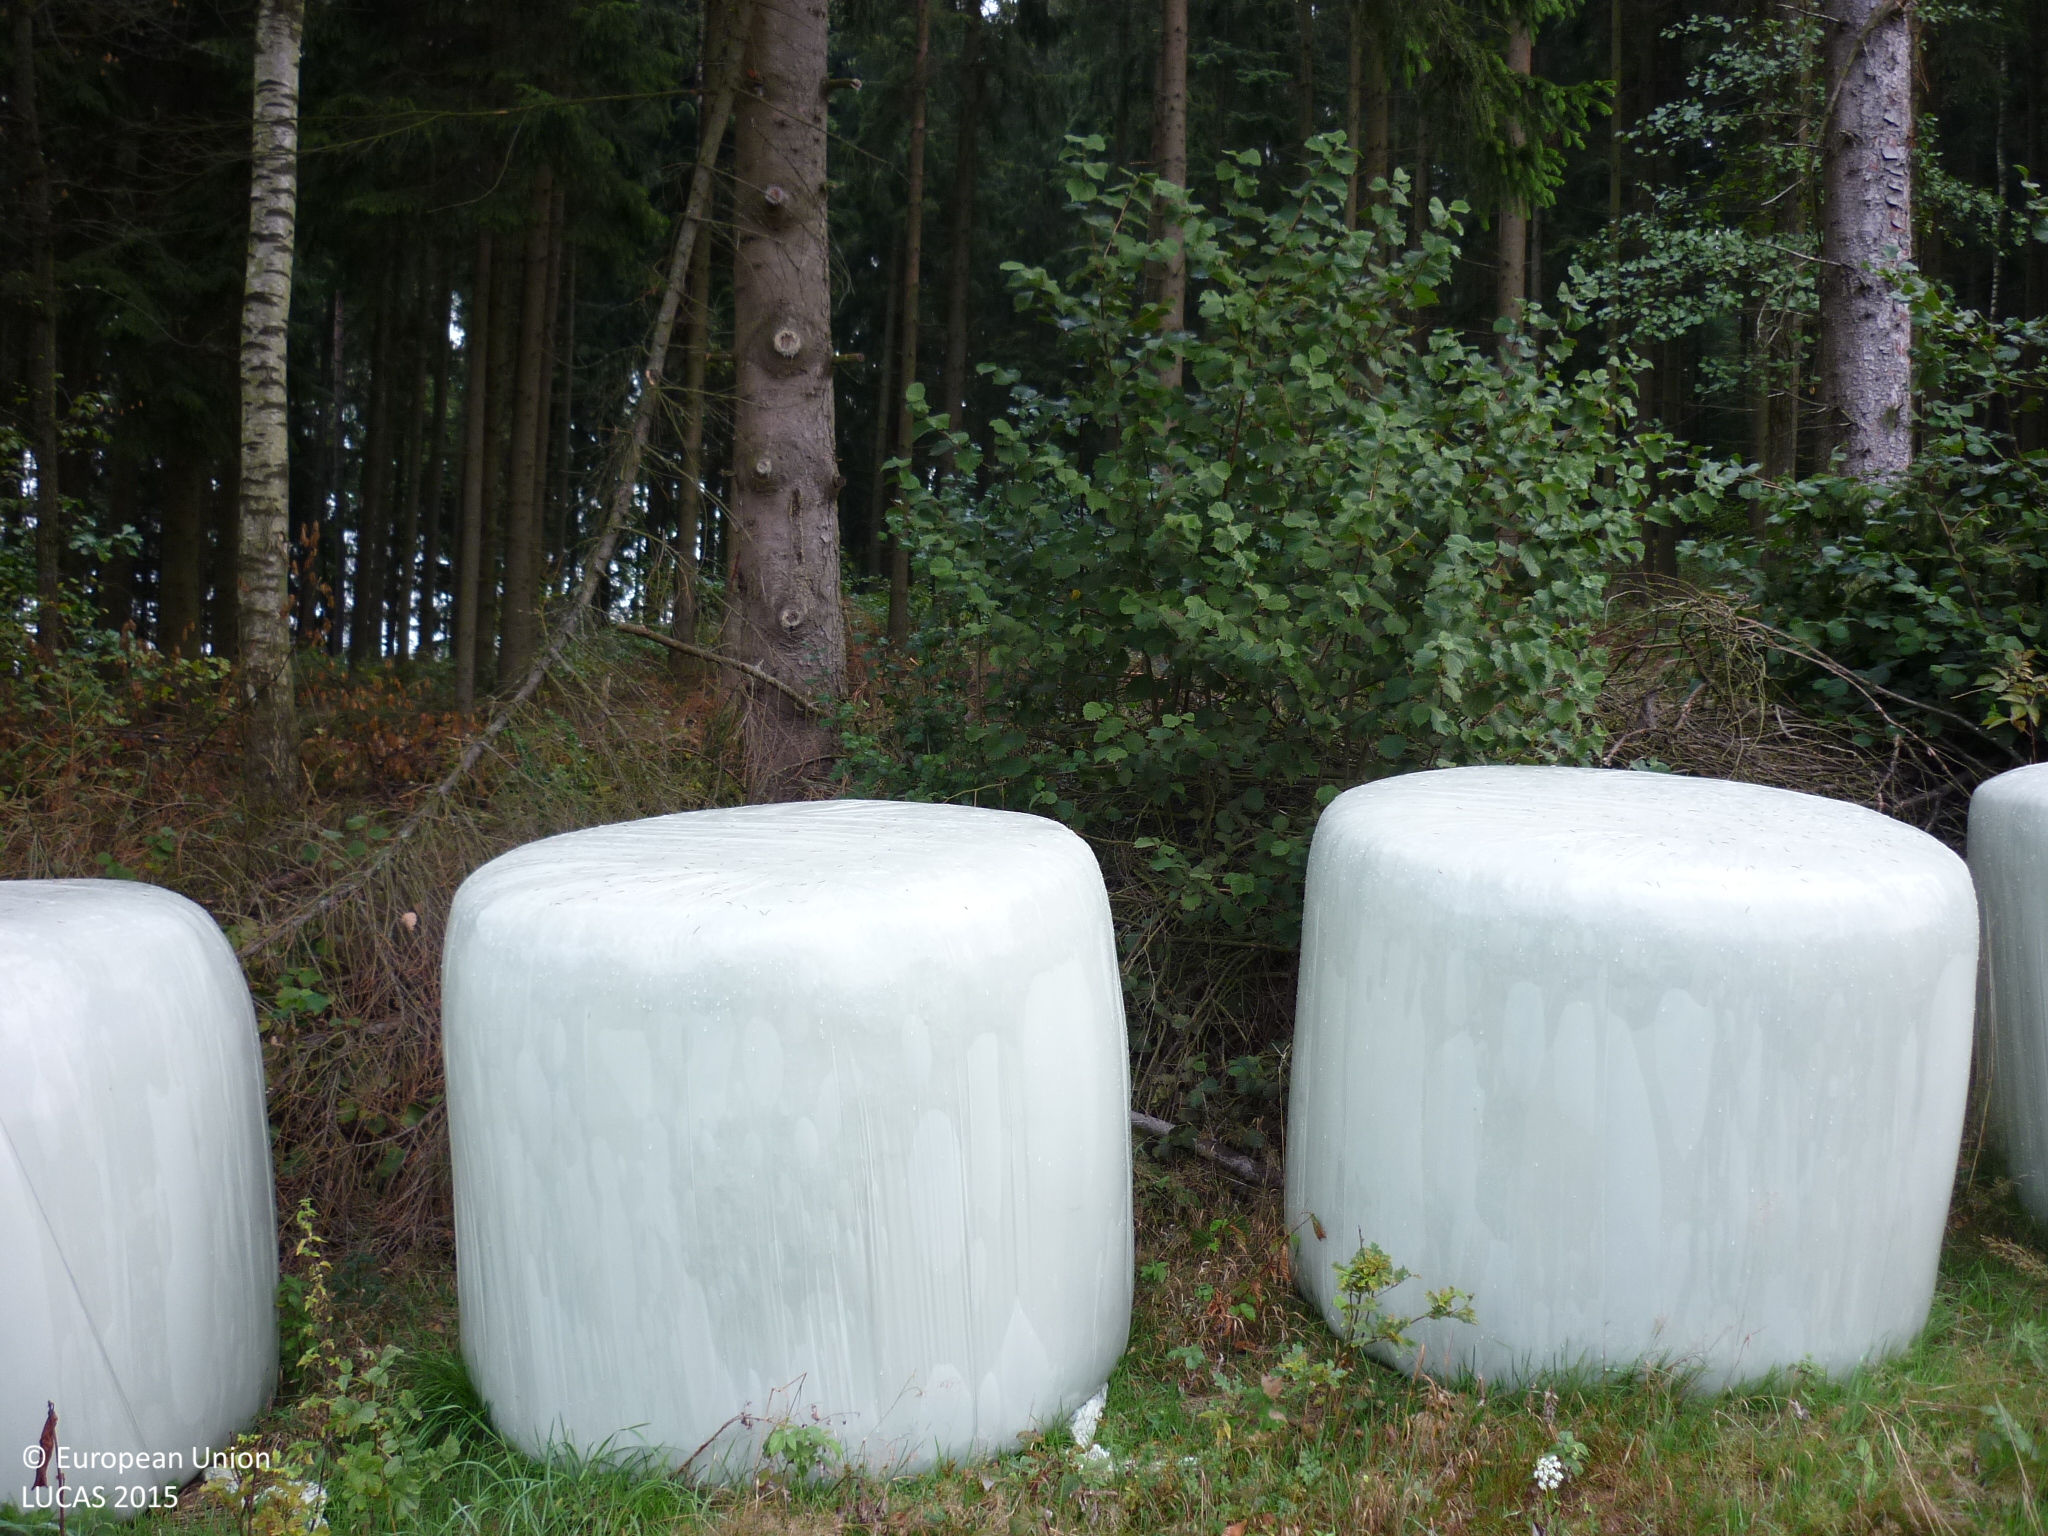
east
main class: Cropland
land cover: Maize
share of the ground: > 75 %
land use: Agriculture (excluding fallow land and kitchen gardens)
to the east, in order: Maize; Grassland without tree/shrub cover; Spruce dominated coniferous woodland; Tracks; Spruce dominated coniferous woodland; Tracks; Spruce dominated coniferous woodland; Tracks; Spruce dominated coniferous woodland; Spruce dominated mixed woodland; Spruce dominated coniferous woodland; Tracks; Broadleaved woodland; Spontaneously vegetated surfaces; Rocks and stones; Pine dominated mixed woodland; Broadleaved woodland; Spruce dominated mixed woodland
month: September
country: AT
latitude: 48.9376
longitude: 15.0396
